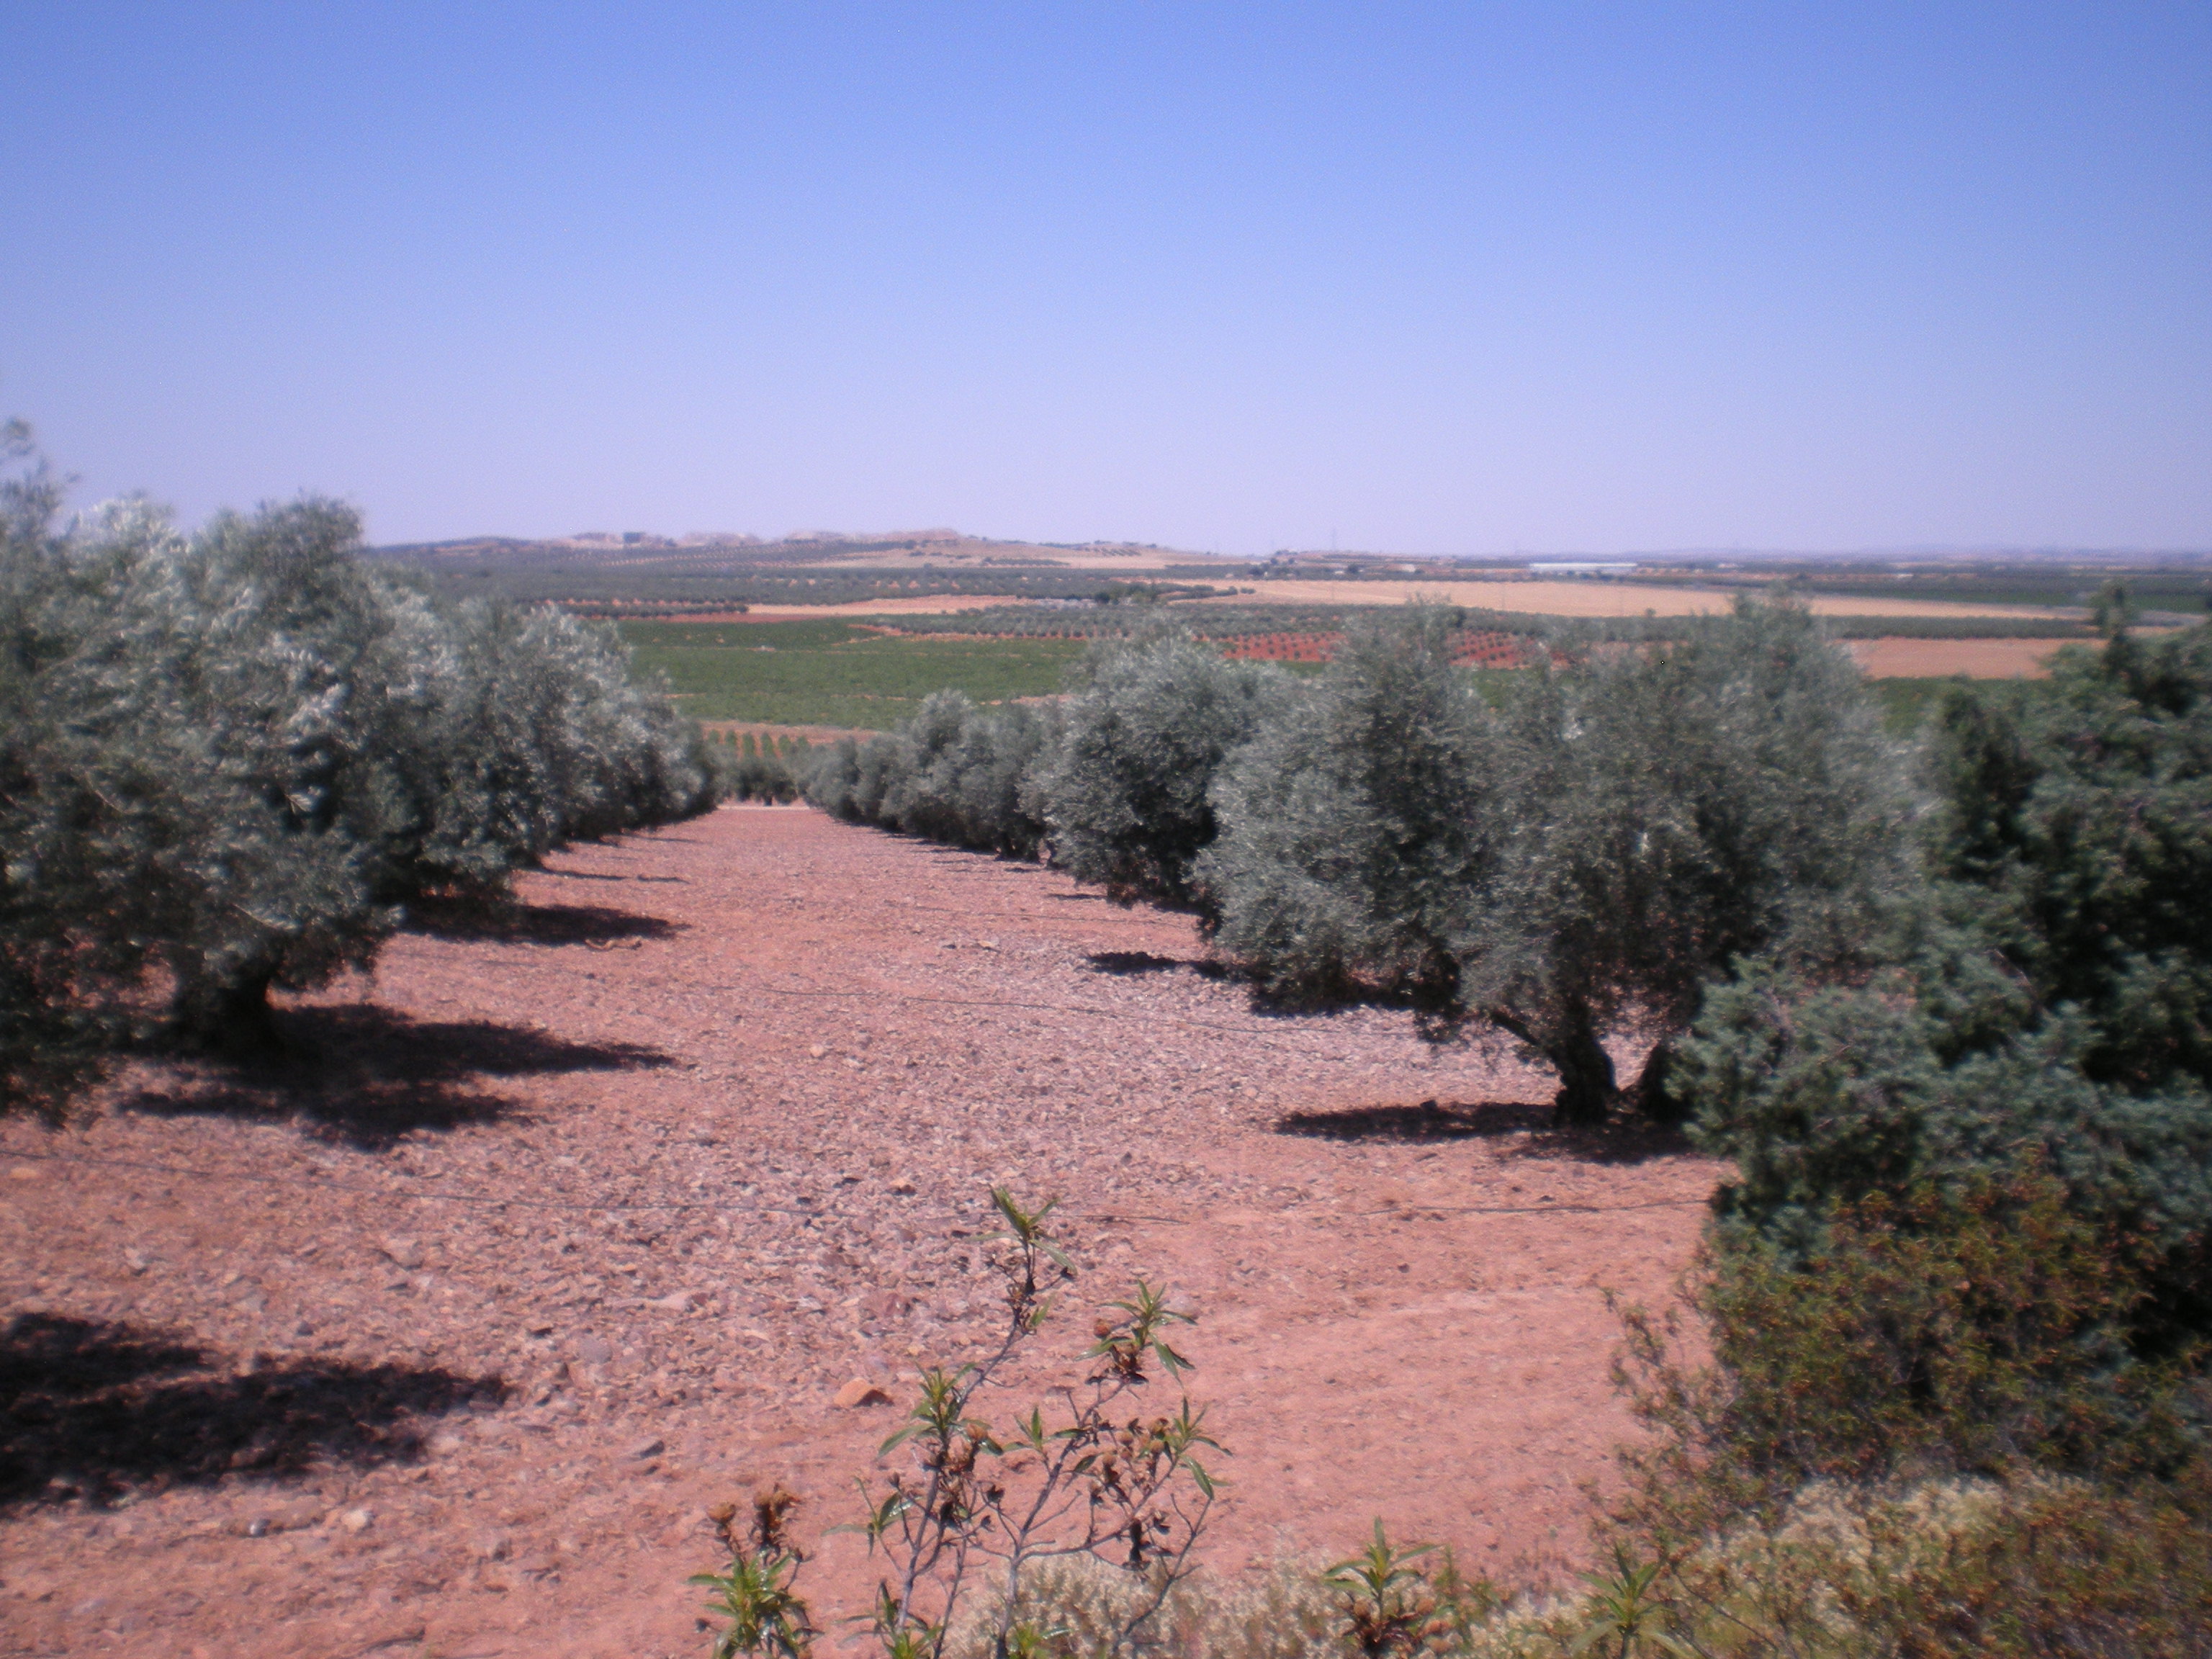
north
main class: Shrubland
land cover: Shrubland with sparse tree cover
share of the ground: > 75 %
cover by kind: shrubs 75 %, herbaceous plants 10 %, unconsolidated bare surface 10 %, broadleaved forest trees 5 %
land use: Semi-natural and natural areas not in use
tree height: < 5 m
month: July
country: ES
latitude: 39.3311
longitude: -3.4889
